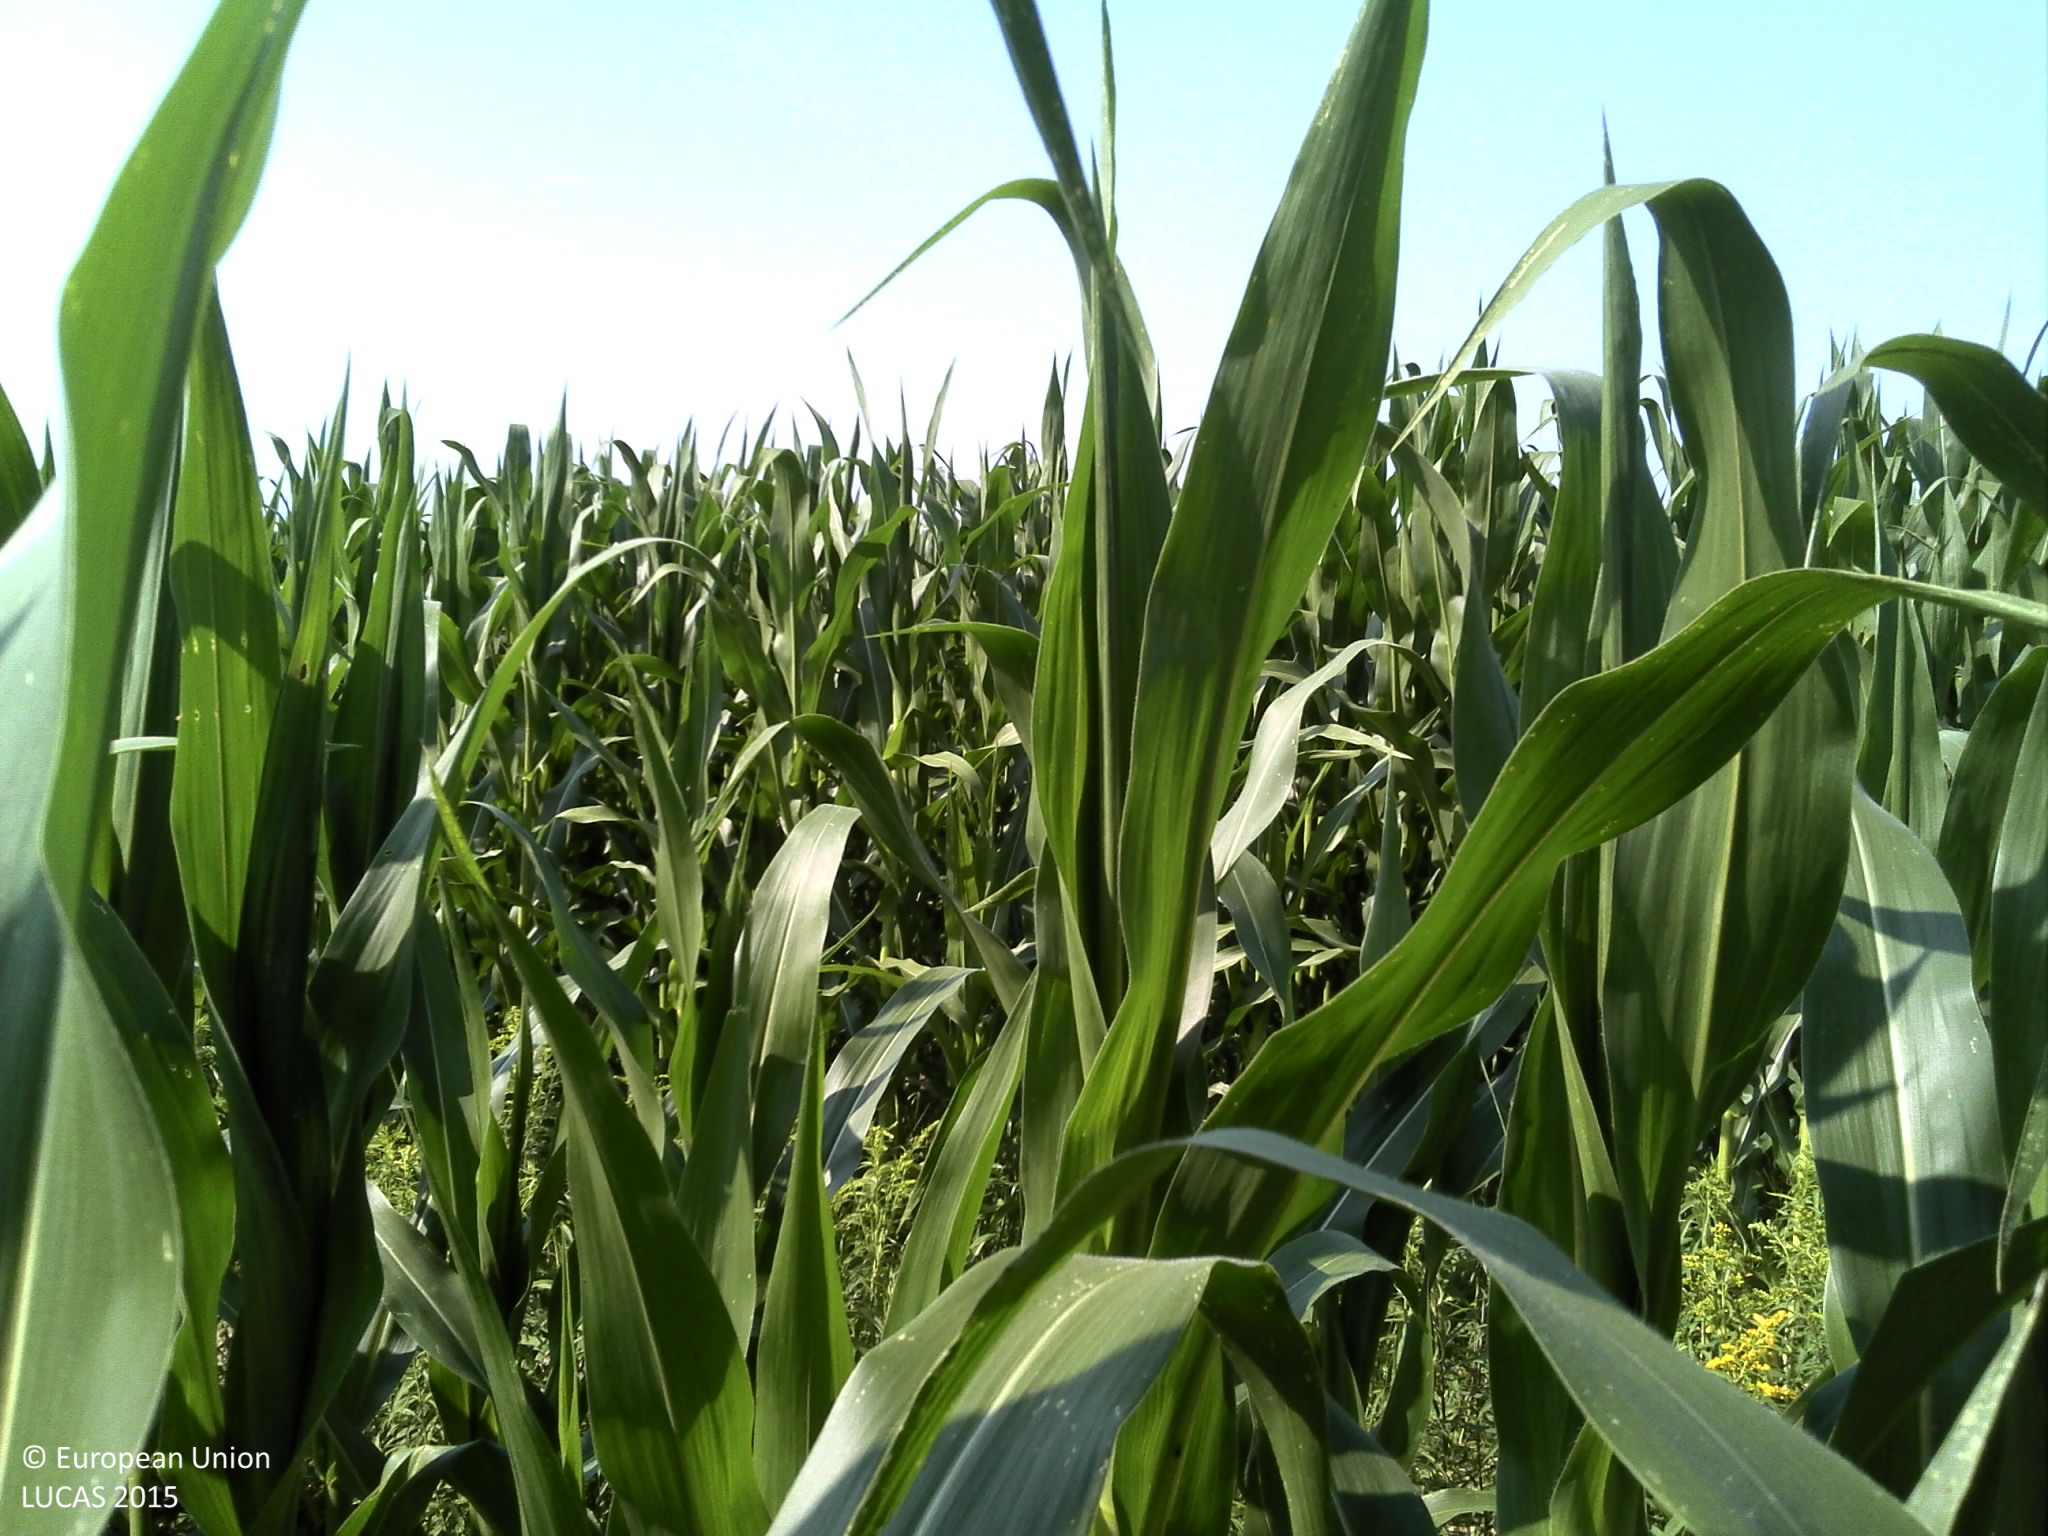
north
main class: Cropland
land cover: Maize
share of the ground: > 75 %
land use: Agriculture (excluding fallow land and kitchen gardens)
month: July
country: HR
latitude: 45.8007
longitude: 16.6514
